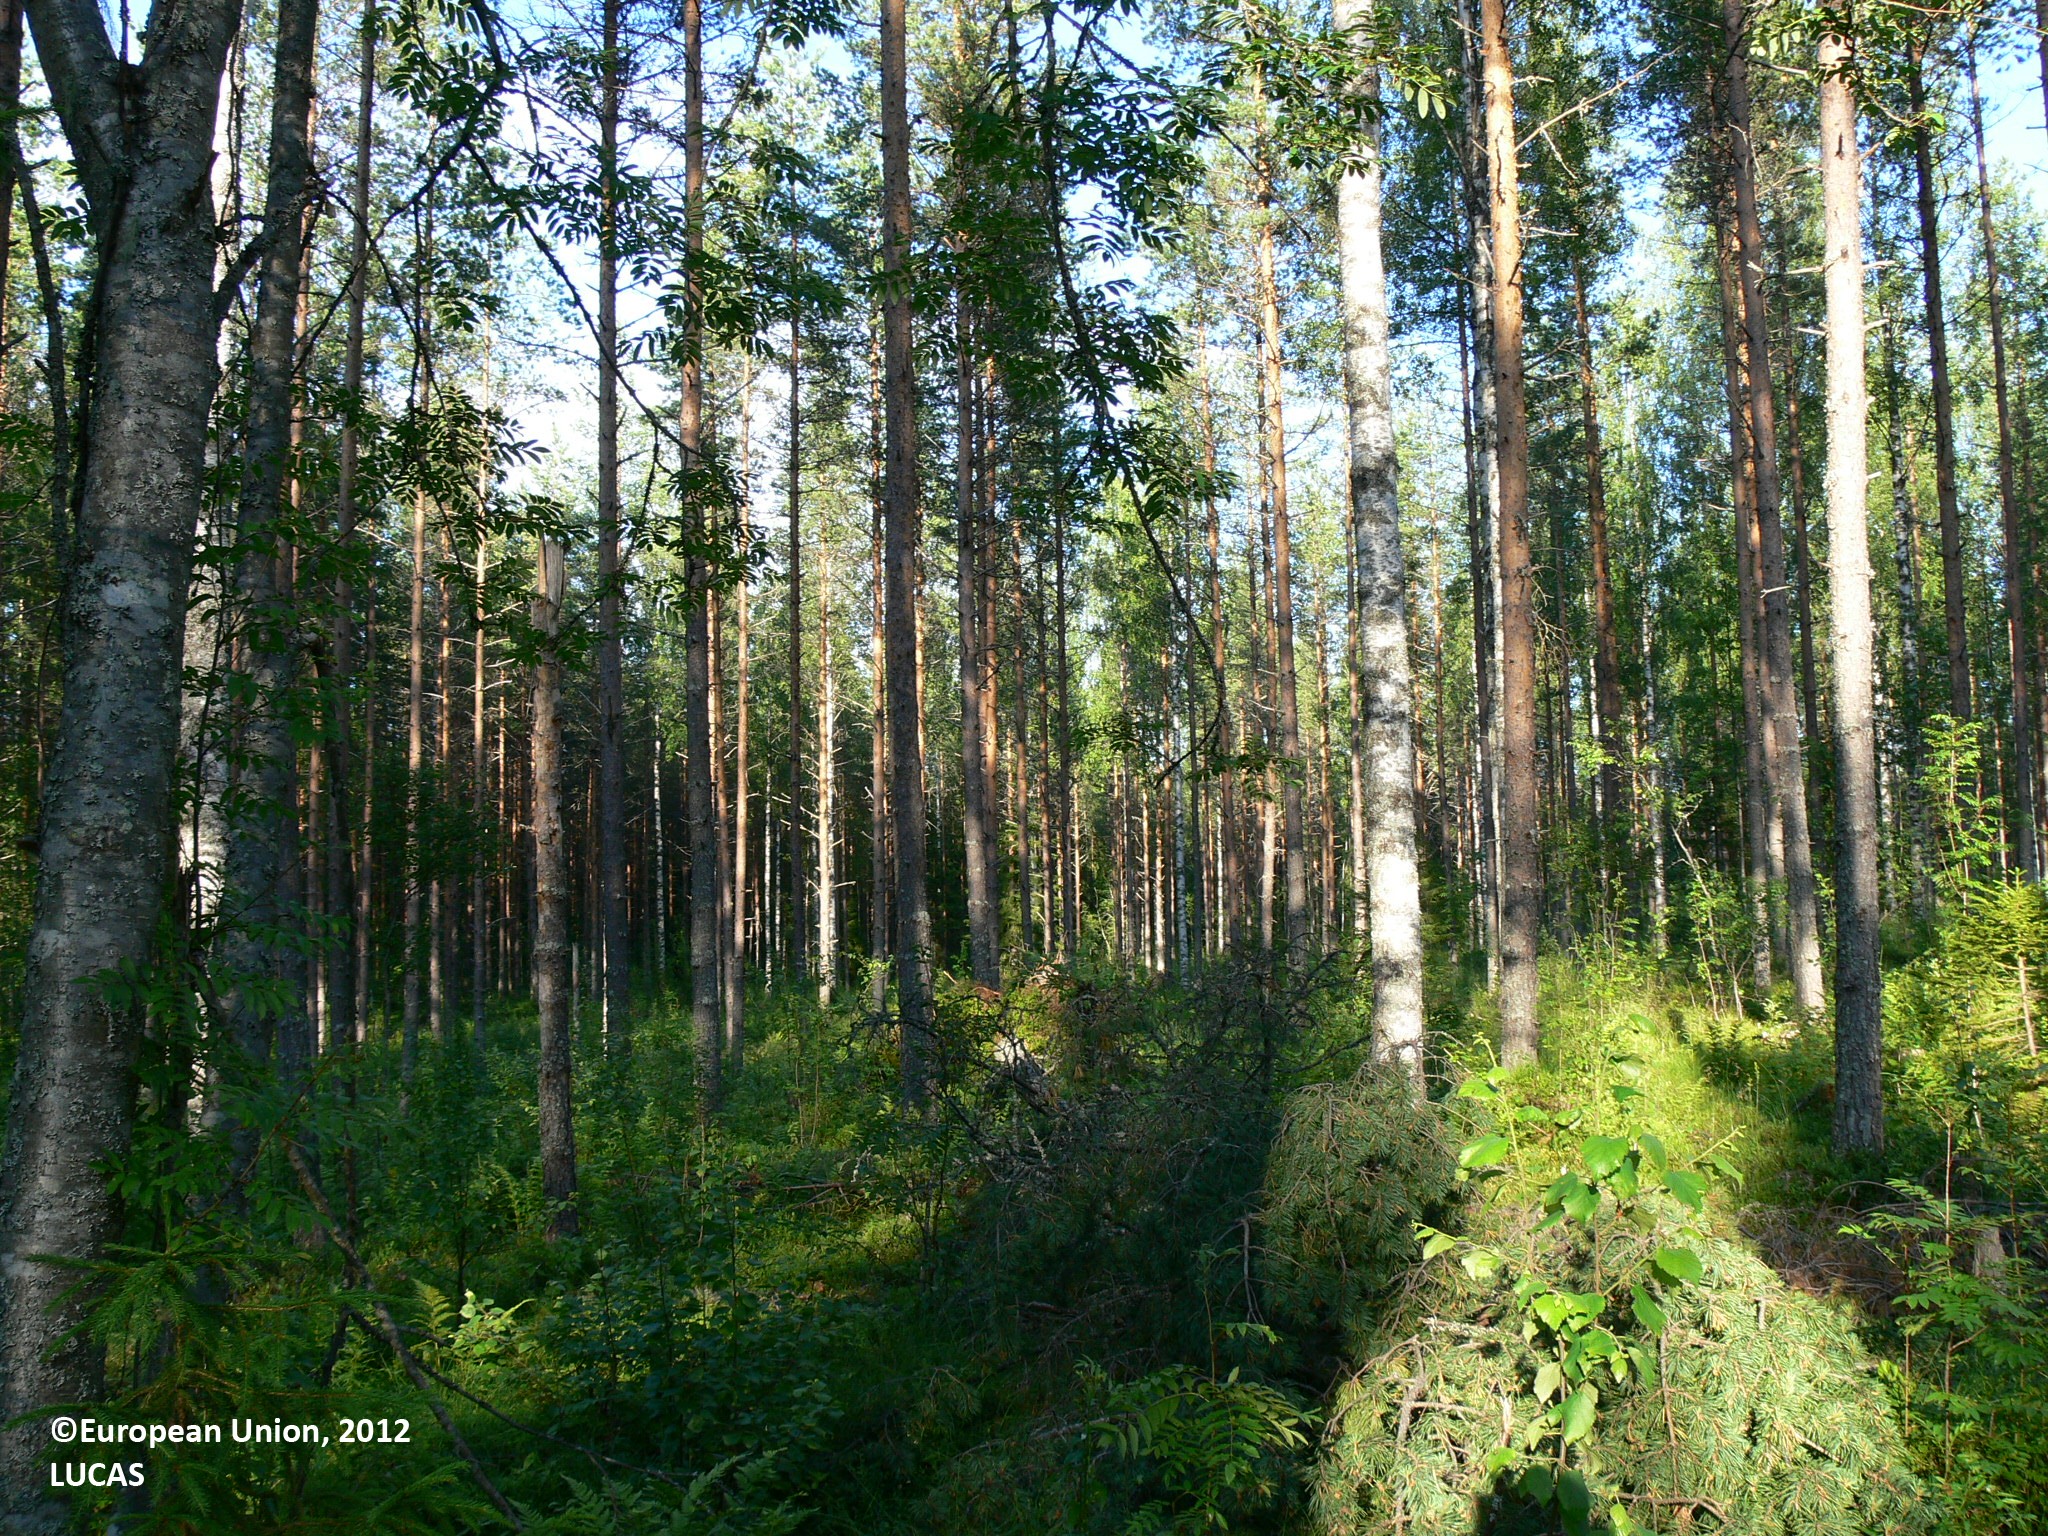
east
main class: Woodland
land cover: Pine dominated mixed woodland
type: boreal forest
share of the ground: > 75 %
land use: Forestry
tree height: > 5 m
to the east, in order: Pine dominated mixed woodland; Pine dominated coniferous woodland; Other coniferous woodland; Ditches and canals; Other coniferous woodland; Pine dominated coniferous woodland
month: July
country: FI
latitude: 63.2985
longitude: 30.8965
